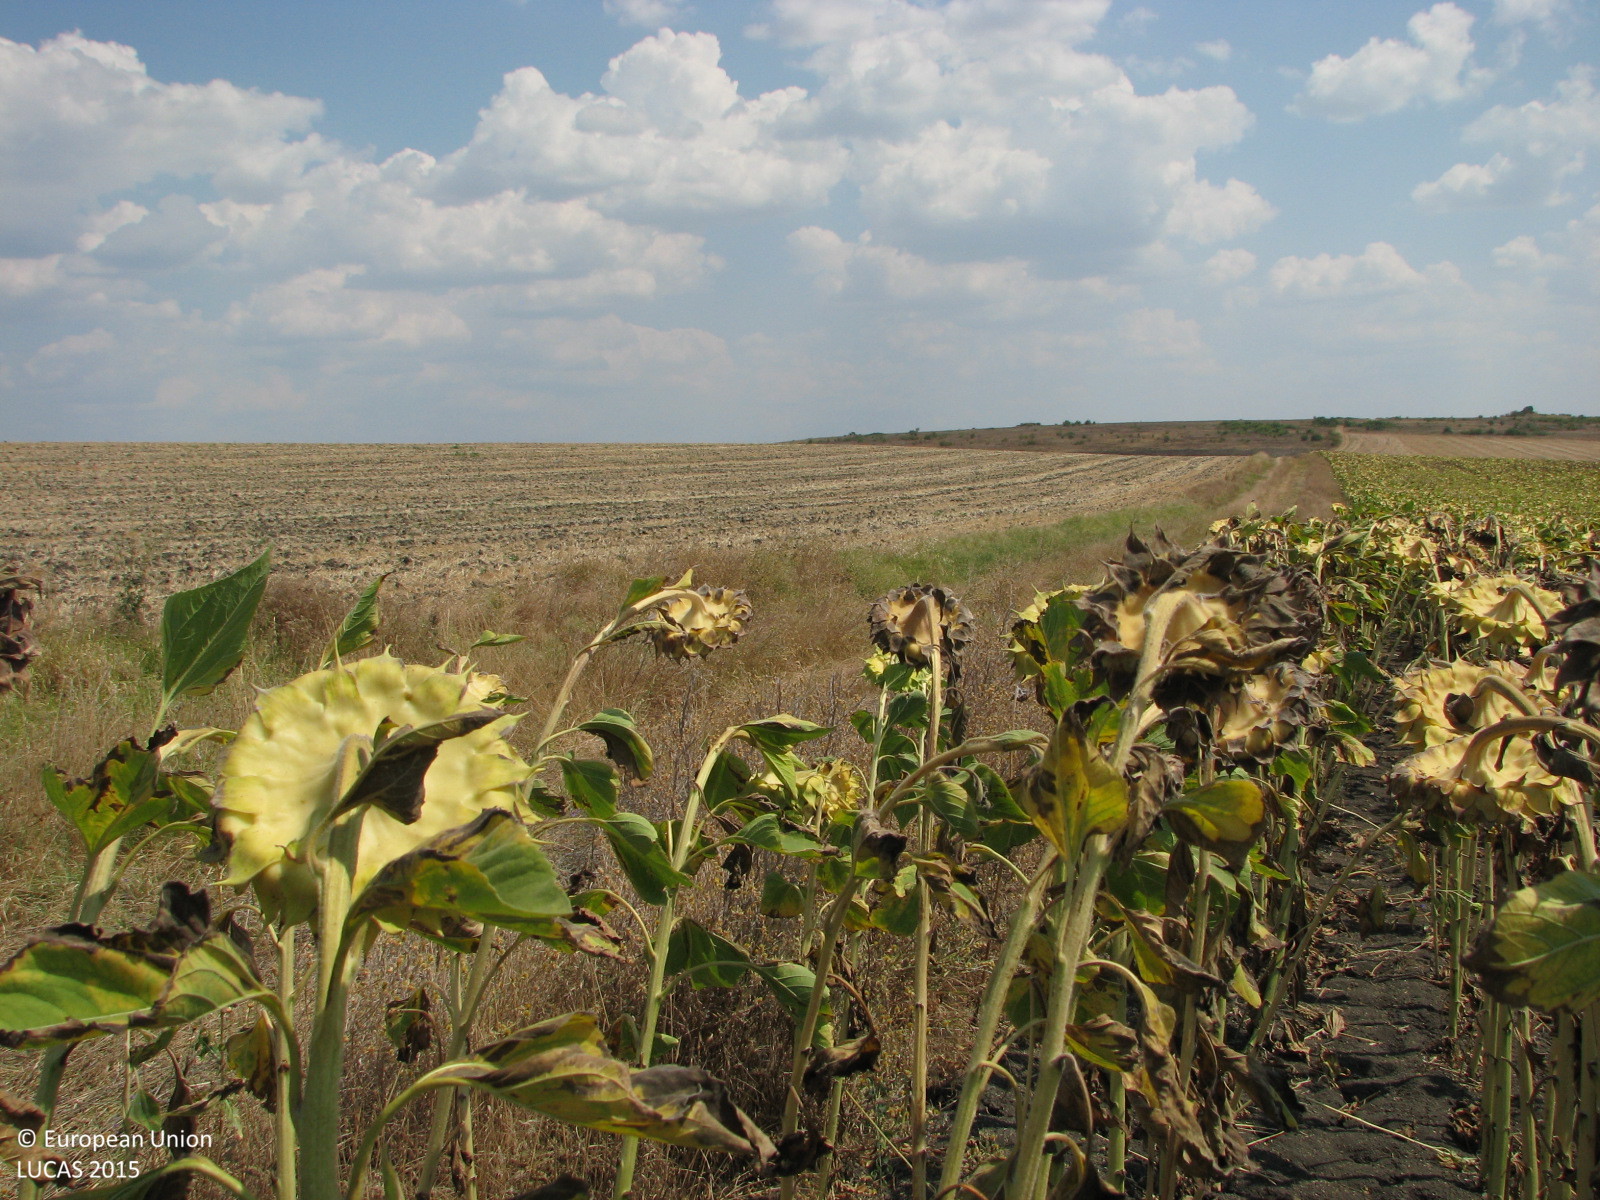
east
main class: Cropland
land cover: Sunflower
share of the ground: > 75 %
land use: Agriculture (excluding fallow land and kitchen gardens)
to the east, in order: Sunflower; Grass margins; Tracks; Grass margins; Common wheat
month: August
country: BG
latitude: 42.1857
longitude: 26.6433
